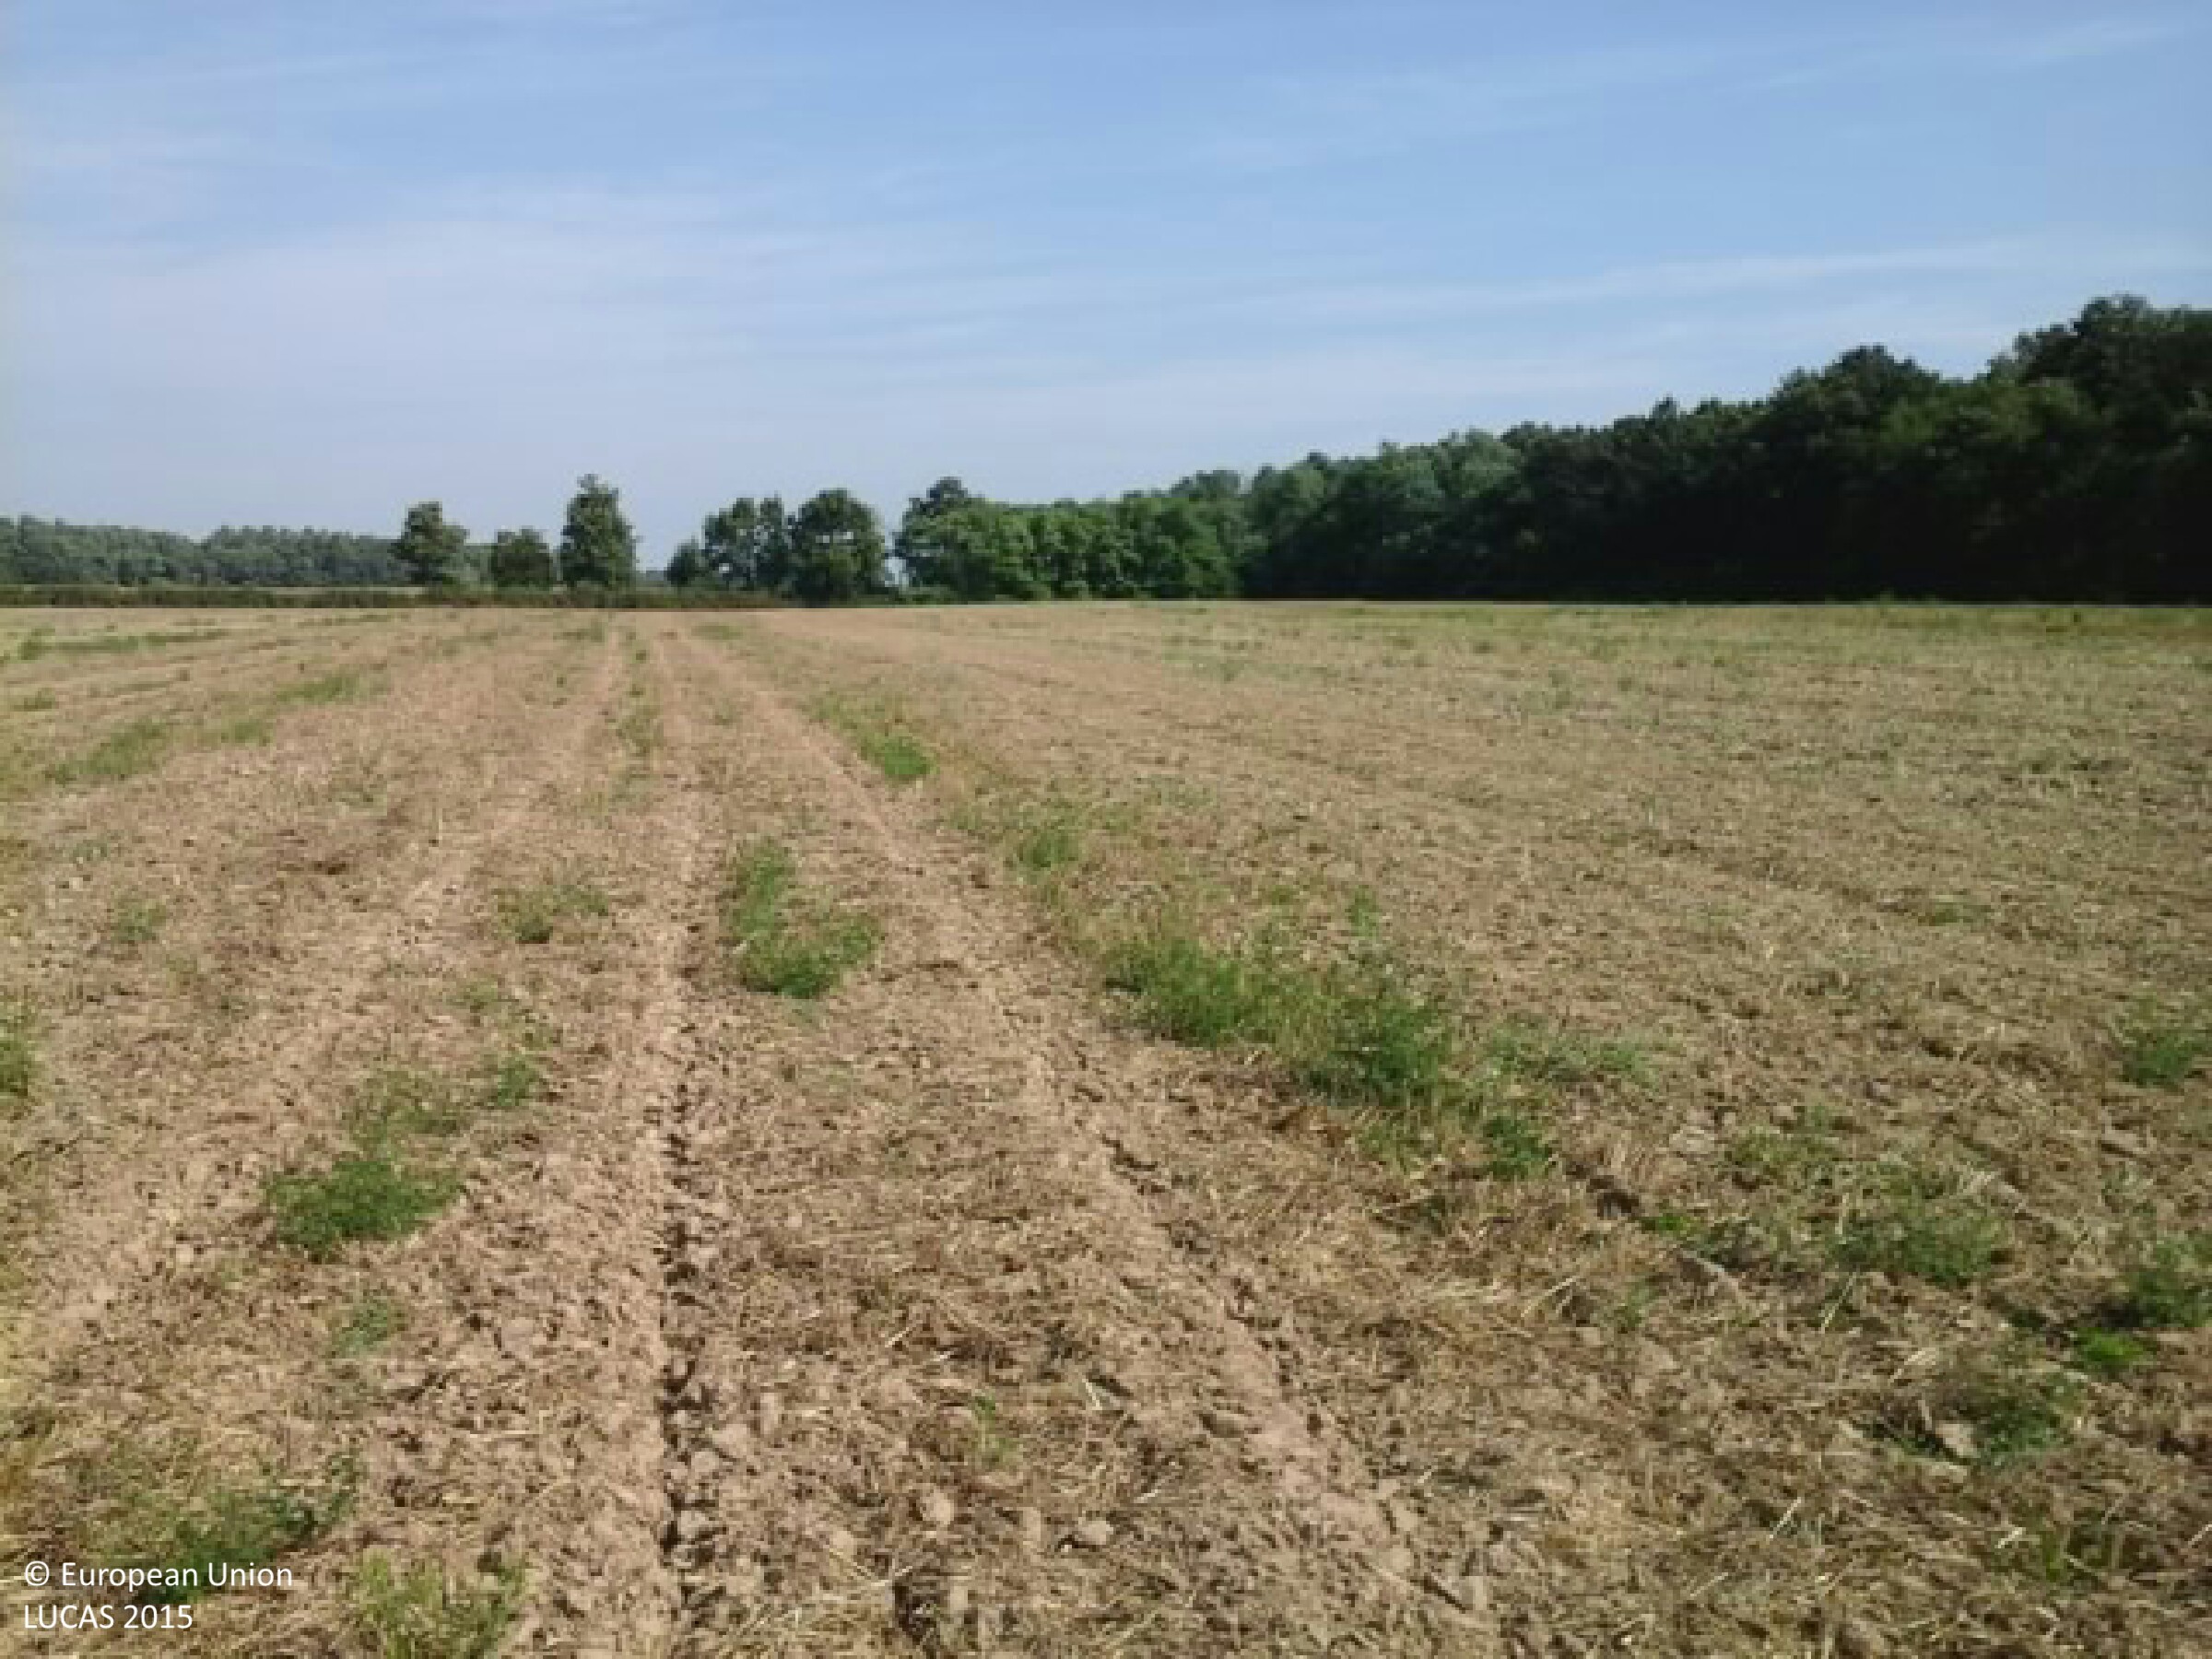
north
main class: Cropland
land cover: Common wheat
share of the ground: 25 - 50 %
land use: Agriculture (excluding fallow land and kitchen gardens)
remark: Harvested field
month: August
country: HU
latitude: 46.5522
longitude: 17.3213
